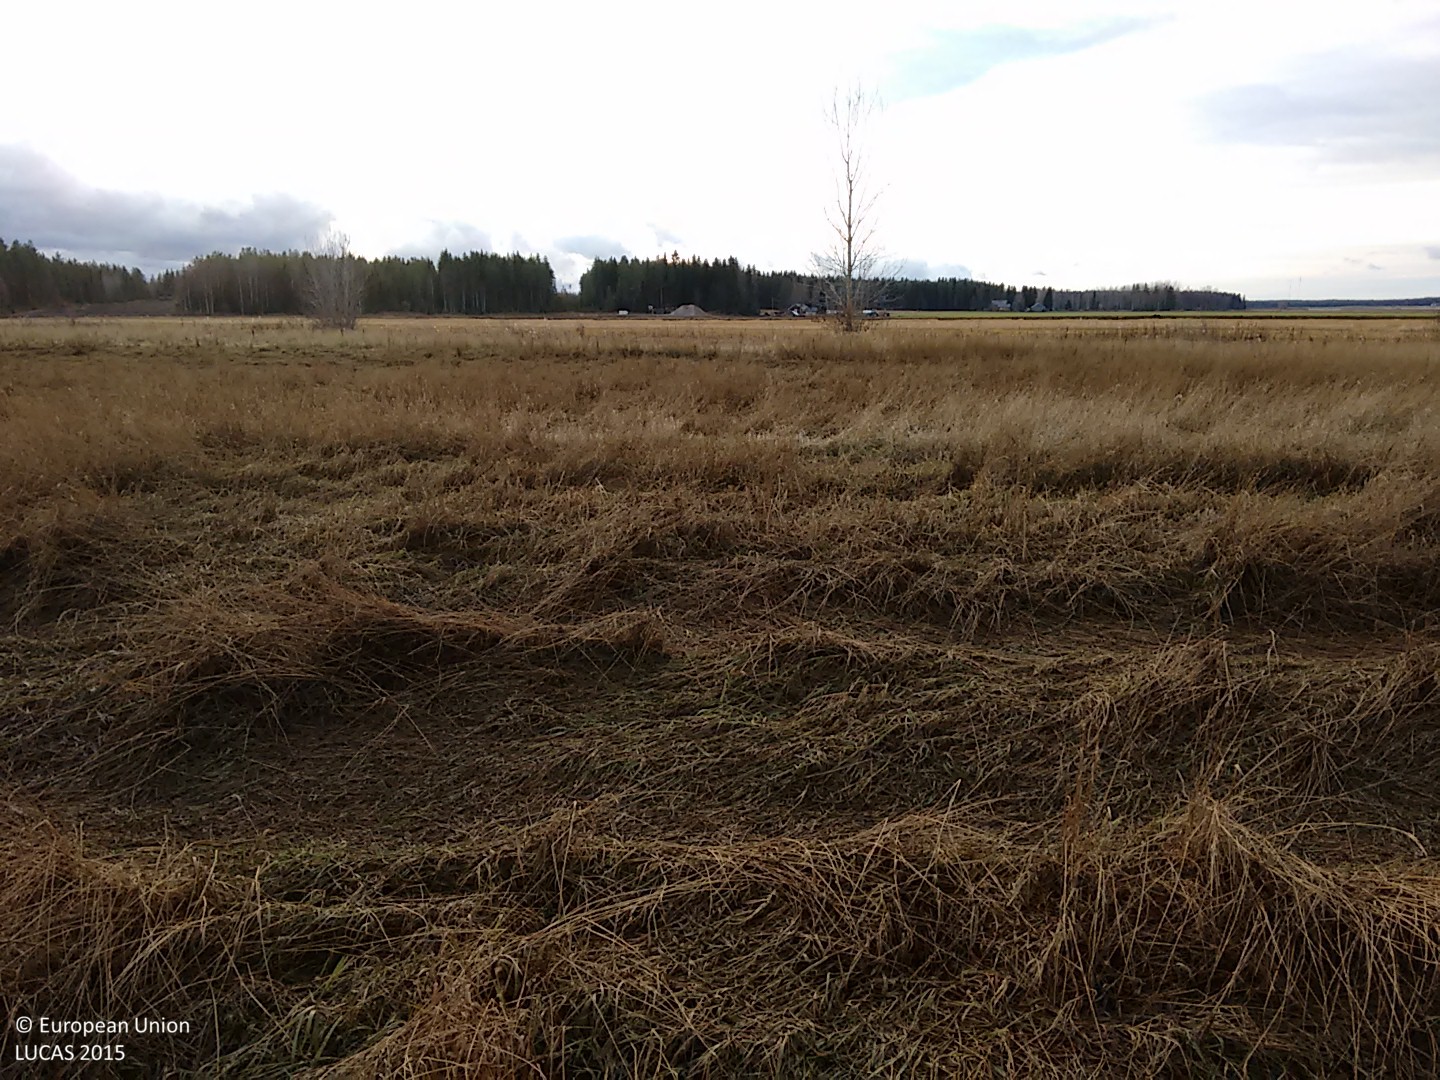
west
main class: Cropland
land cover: Temporary grasslands
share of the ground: > 75 %
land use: Agriculture (excluding fallow land and kitchen gardens)
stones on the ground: < 10 %
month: October
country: FI
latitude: 63.9478
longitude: 25.0869
